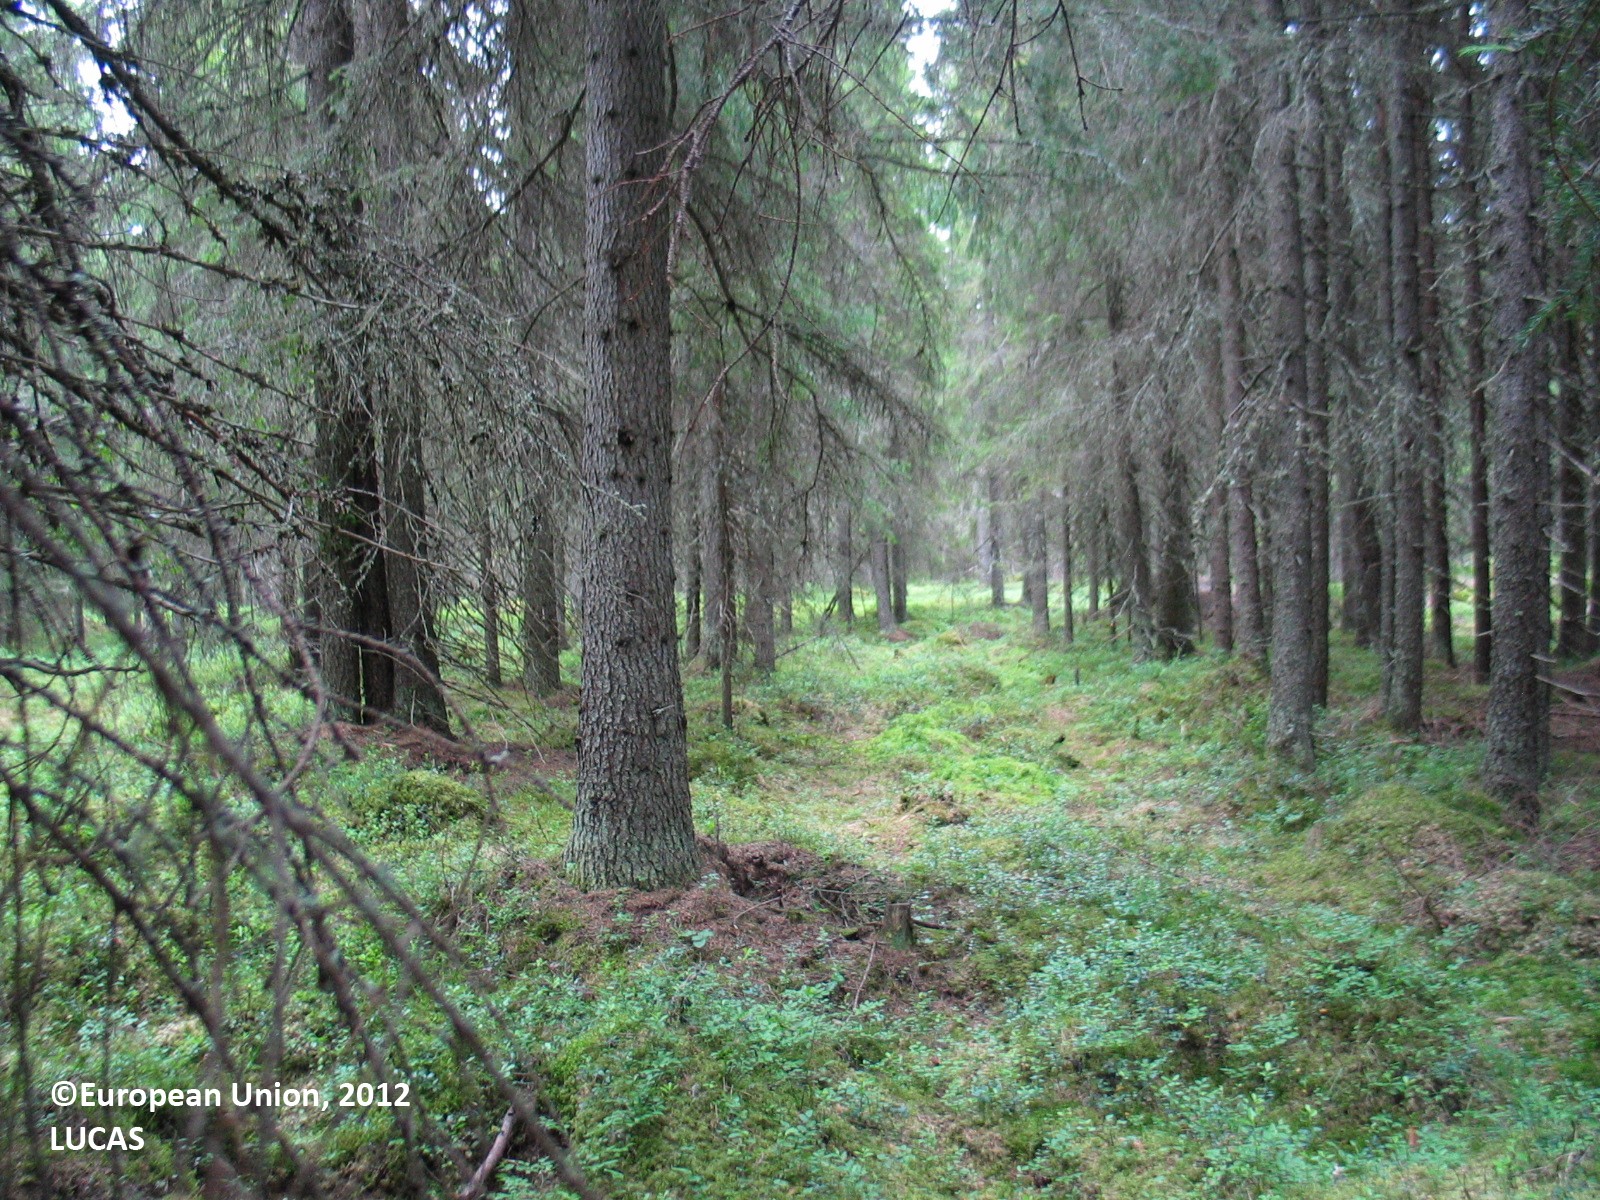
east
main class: Woodland
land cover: Spruce dominated coniferous woodland
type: mire and swamp forests
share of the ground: 50 - 75 %
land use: Forestry
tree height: > 5 m
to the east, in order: Spruce dominated coniferous woodland; Ditches and canals; Other mixed woodland; Ditches and canals; Spruce dominated coniferous woodland; Ditches and canals; Grass margins; Spruce dominated coniferous woodland; Other mixed woodland
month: July
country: FI
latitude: 65.6482
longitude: 25.0853
